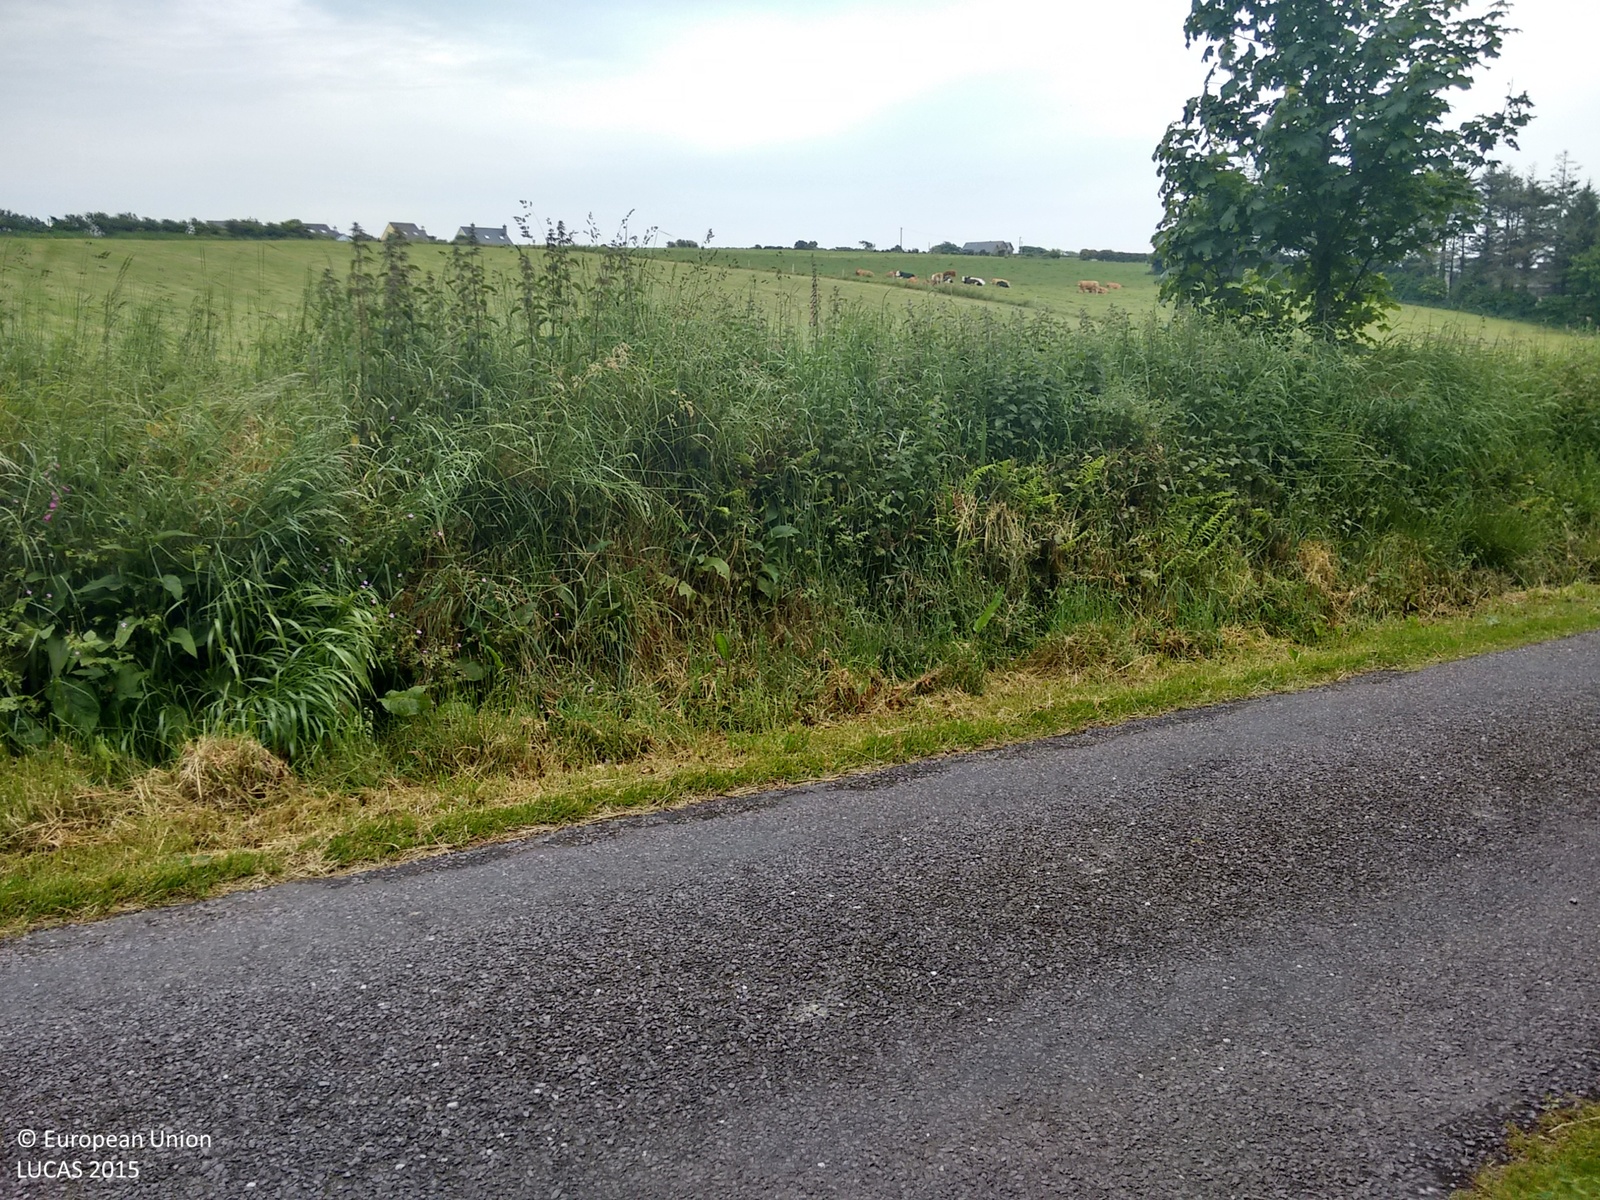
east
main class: Woodland
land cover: Broadleaved woodland
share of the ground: > 75 %
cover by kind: broadleaved forest trees 100 %
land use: Semi-natural and natural areas not in use
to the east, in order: Broadleaved woodland; Electric lines; Grass margins; Paved roads, cycling and walking lanes; Abandoned hedges; Grassland without tree/shrub cover; Fences; Abandoned hedges; Grassland without tree/shrub cover; Abandoned hedges; Fences; Grassland without tree/shrub cover
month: June
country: IE
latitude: 51.6281
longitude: -8.7071
